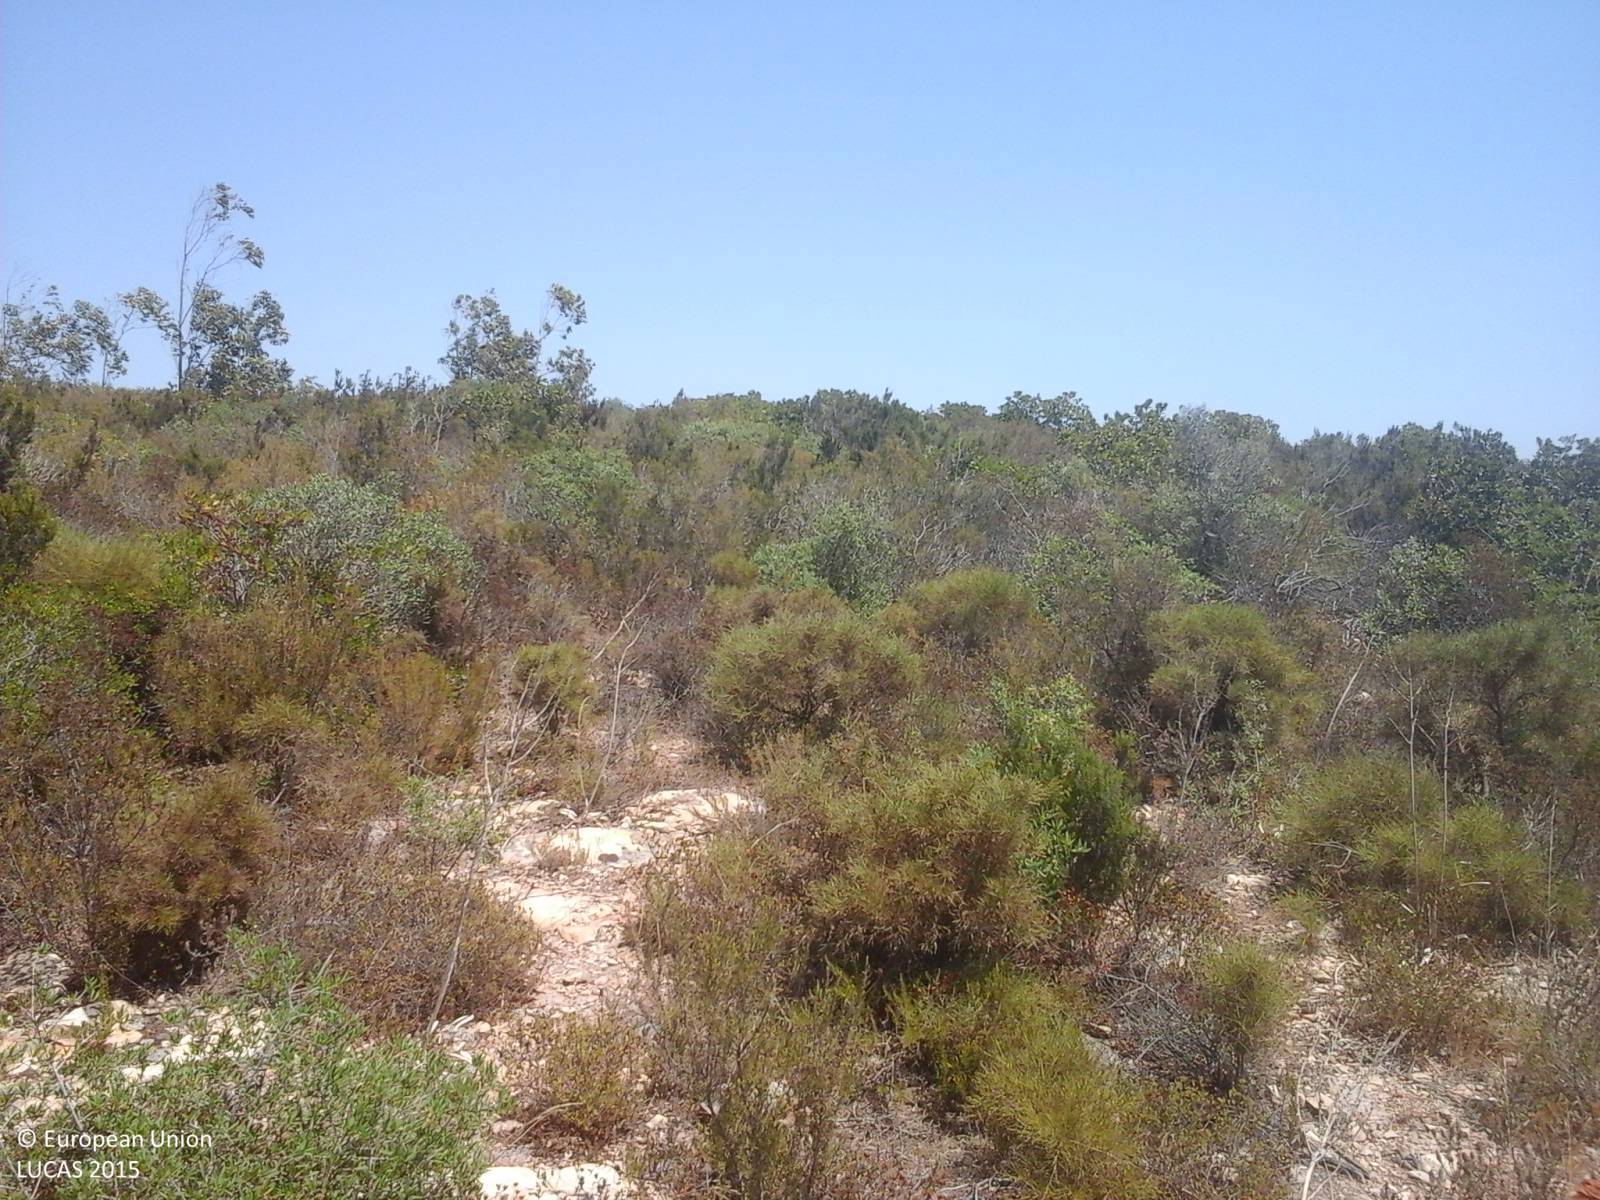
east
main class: Grassland
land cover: Grassland without tree/shrub cover
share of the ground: > 75 %
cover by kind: herbaceous plants 75 %, unconsolidated bare surface 25 %
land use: Agriculture (excluding fallow land and kitchen gardens)
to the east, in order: Grassland without tree/shrub cover; Shrubland without tree cover; Ditches and canals; Shrubland without tree cover; Ditches and canals; Abandoned hedges; Broadleaved woodland; Tracks; Shrubland without tree cover; Fences; Shrubland without tree cover; Paved roads, cycling and walking lanes; Grassland without tree/shrub cover
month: July
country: IT
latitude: 39.1504
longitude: 8.4706
